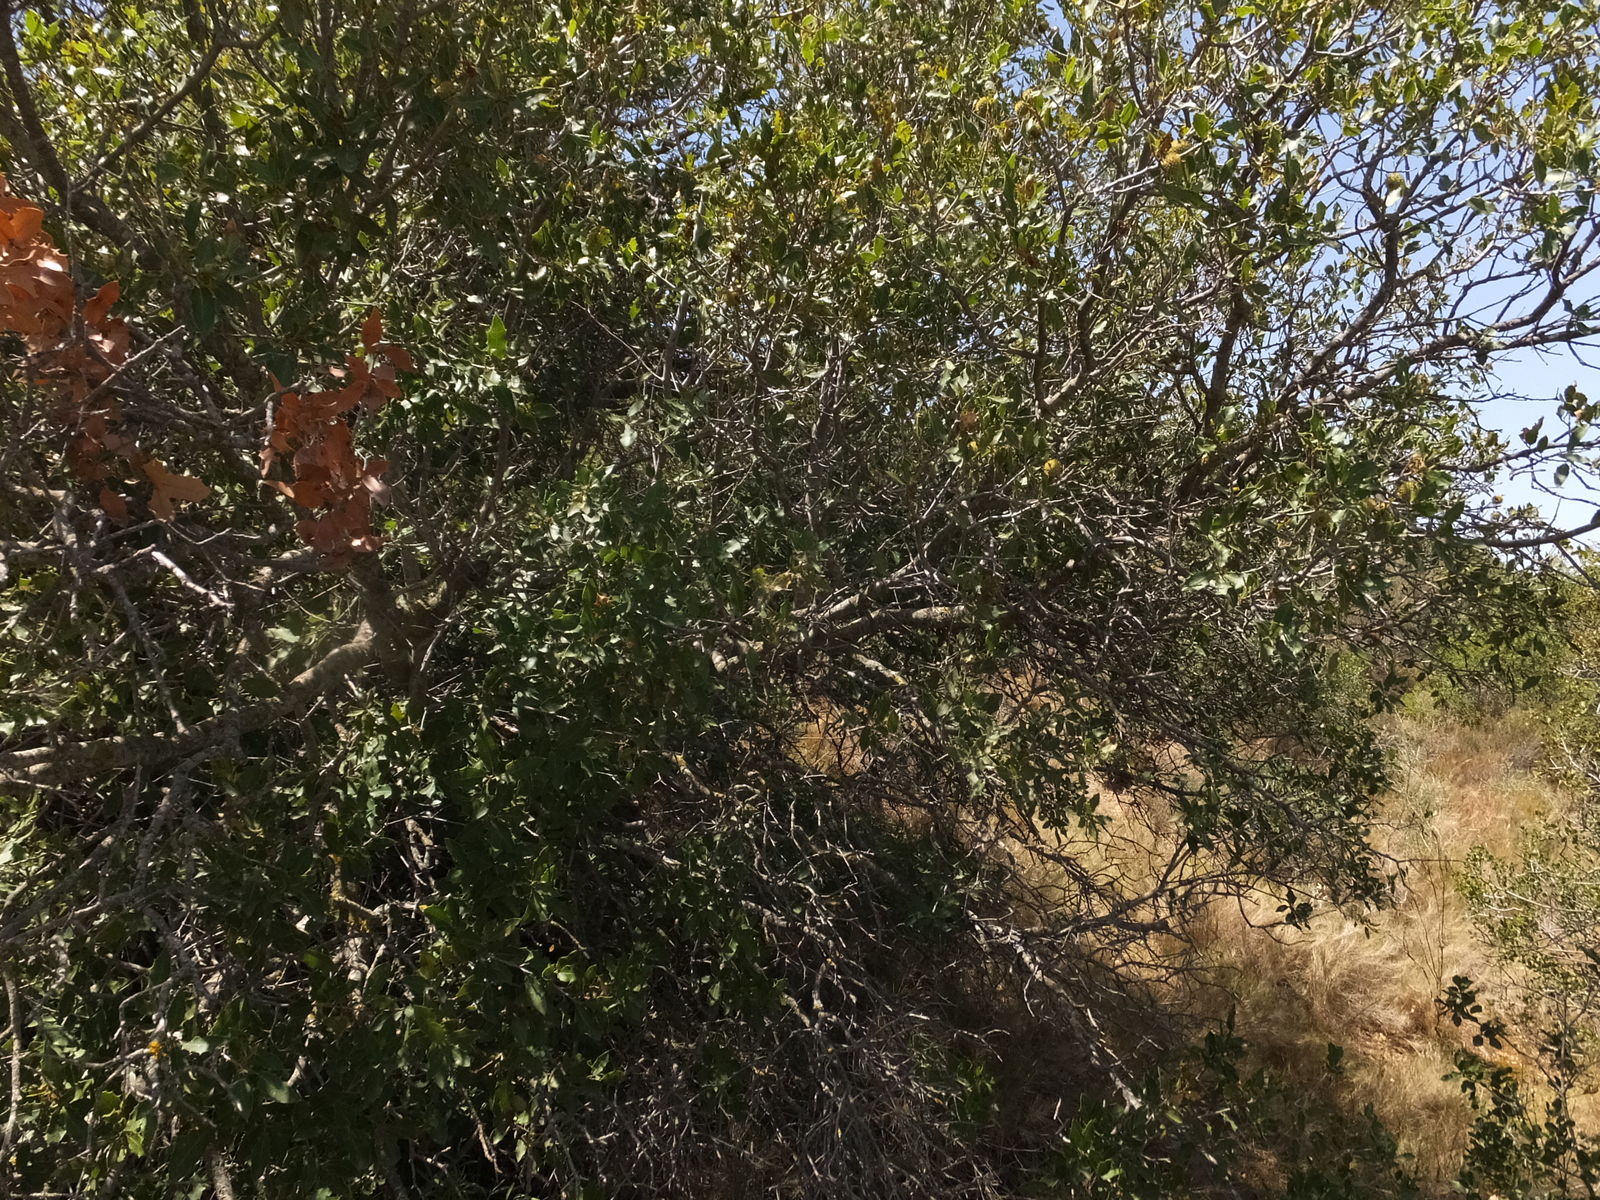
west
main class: Woodland
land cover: Broadleaved woodland
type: broadleaved evergreen forest
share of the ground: > 75 %
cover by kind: broadleaved forest trees 60 %, shrubs 35 %, coniferous forest trees 5 %
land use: Forestry
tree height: < 5 m
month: July
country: ES
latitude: 41.4226
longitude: 0.4762
